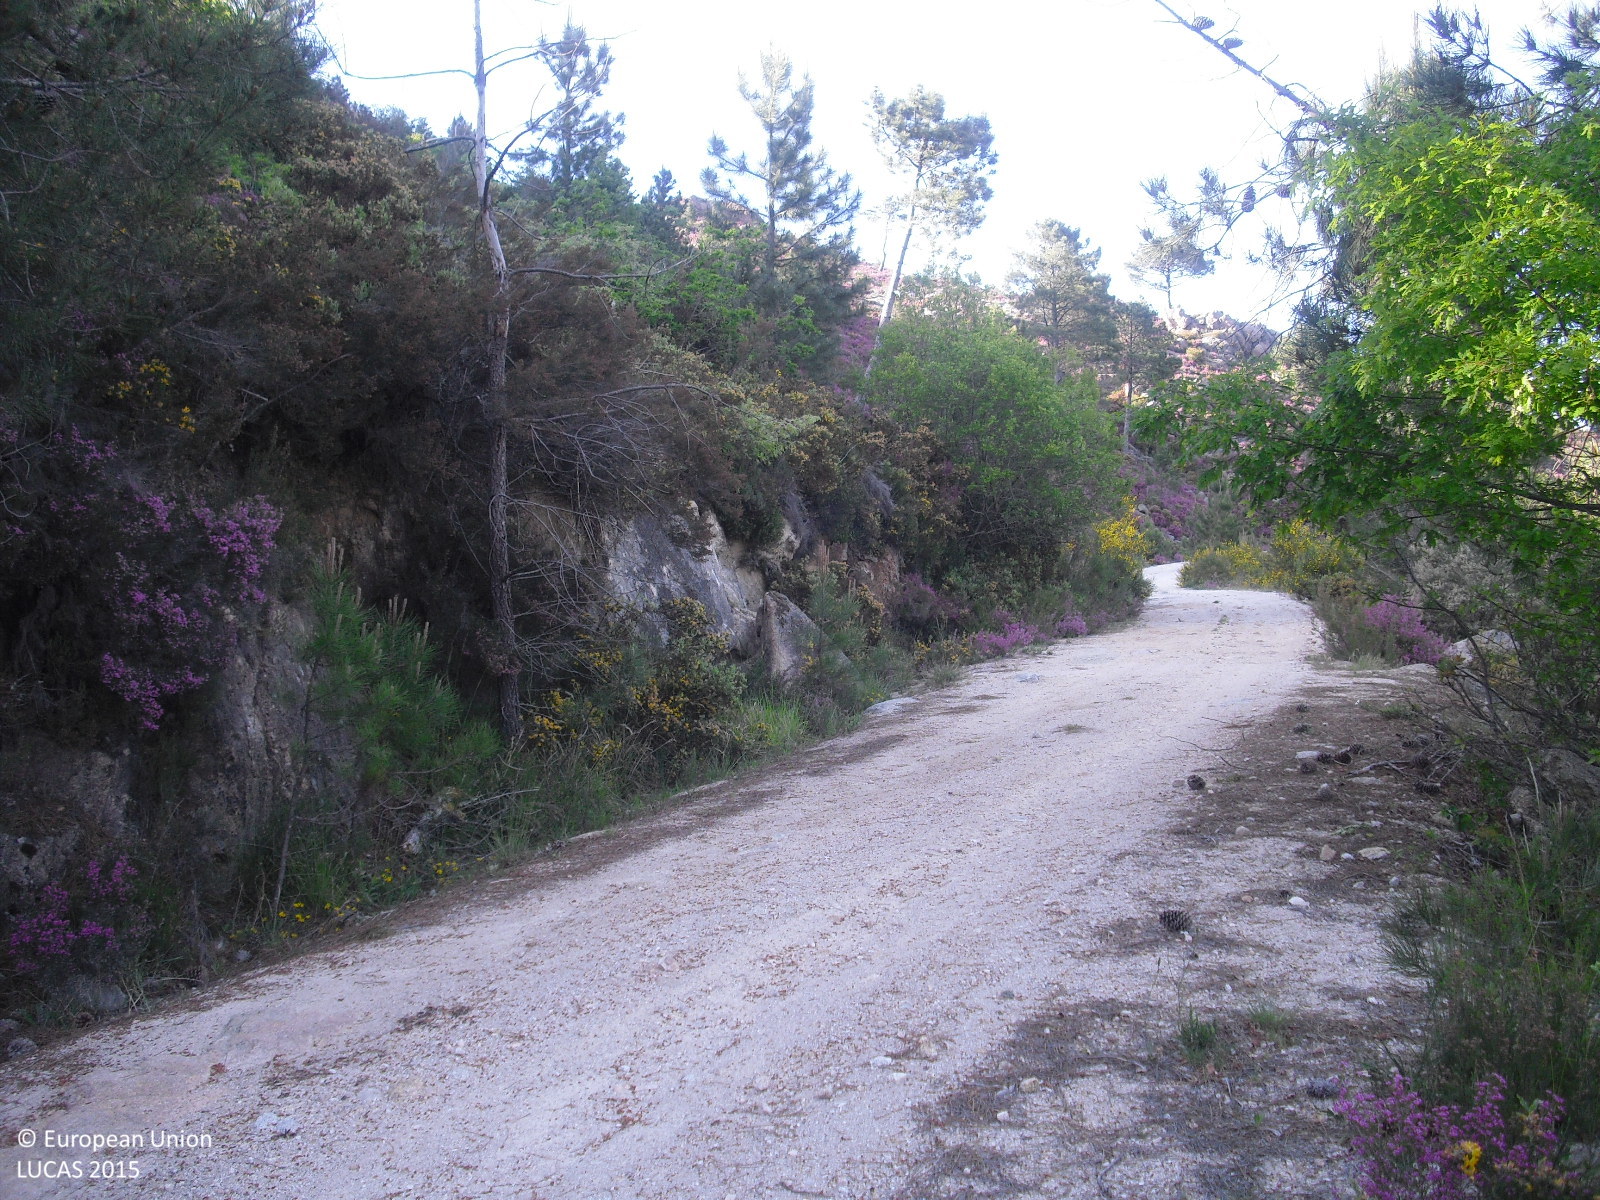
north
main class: Woodland
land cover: Pine dominated mixed woodland
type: hemiboreal forest and nemoral coniferous forest and mixed broadleaved-coniferous forest
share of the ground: 25 - 50 %
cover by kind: shrubs 50 %, coniferous forest trees 30 %, broadleaved forest trees 10 %, consolidated bare surface 10 %
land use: Semi-natural and natural areas not in use
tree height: > 5 m
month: May
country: ES
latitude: 41.8286
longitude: -8.1509
